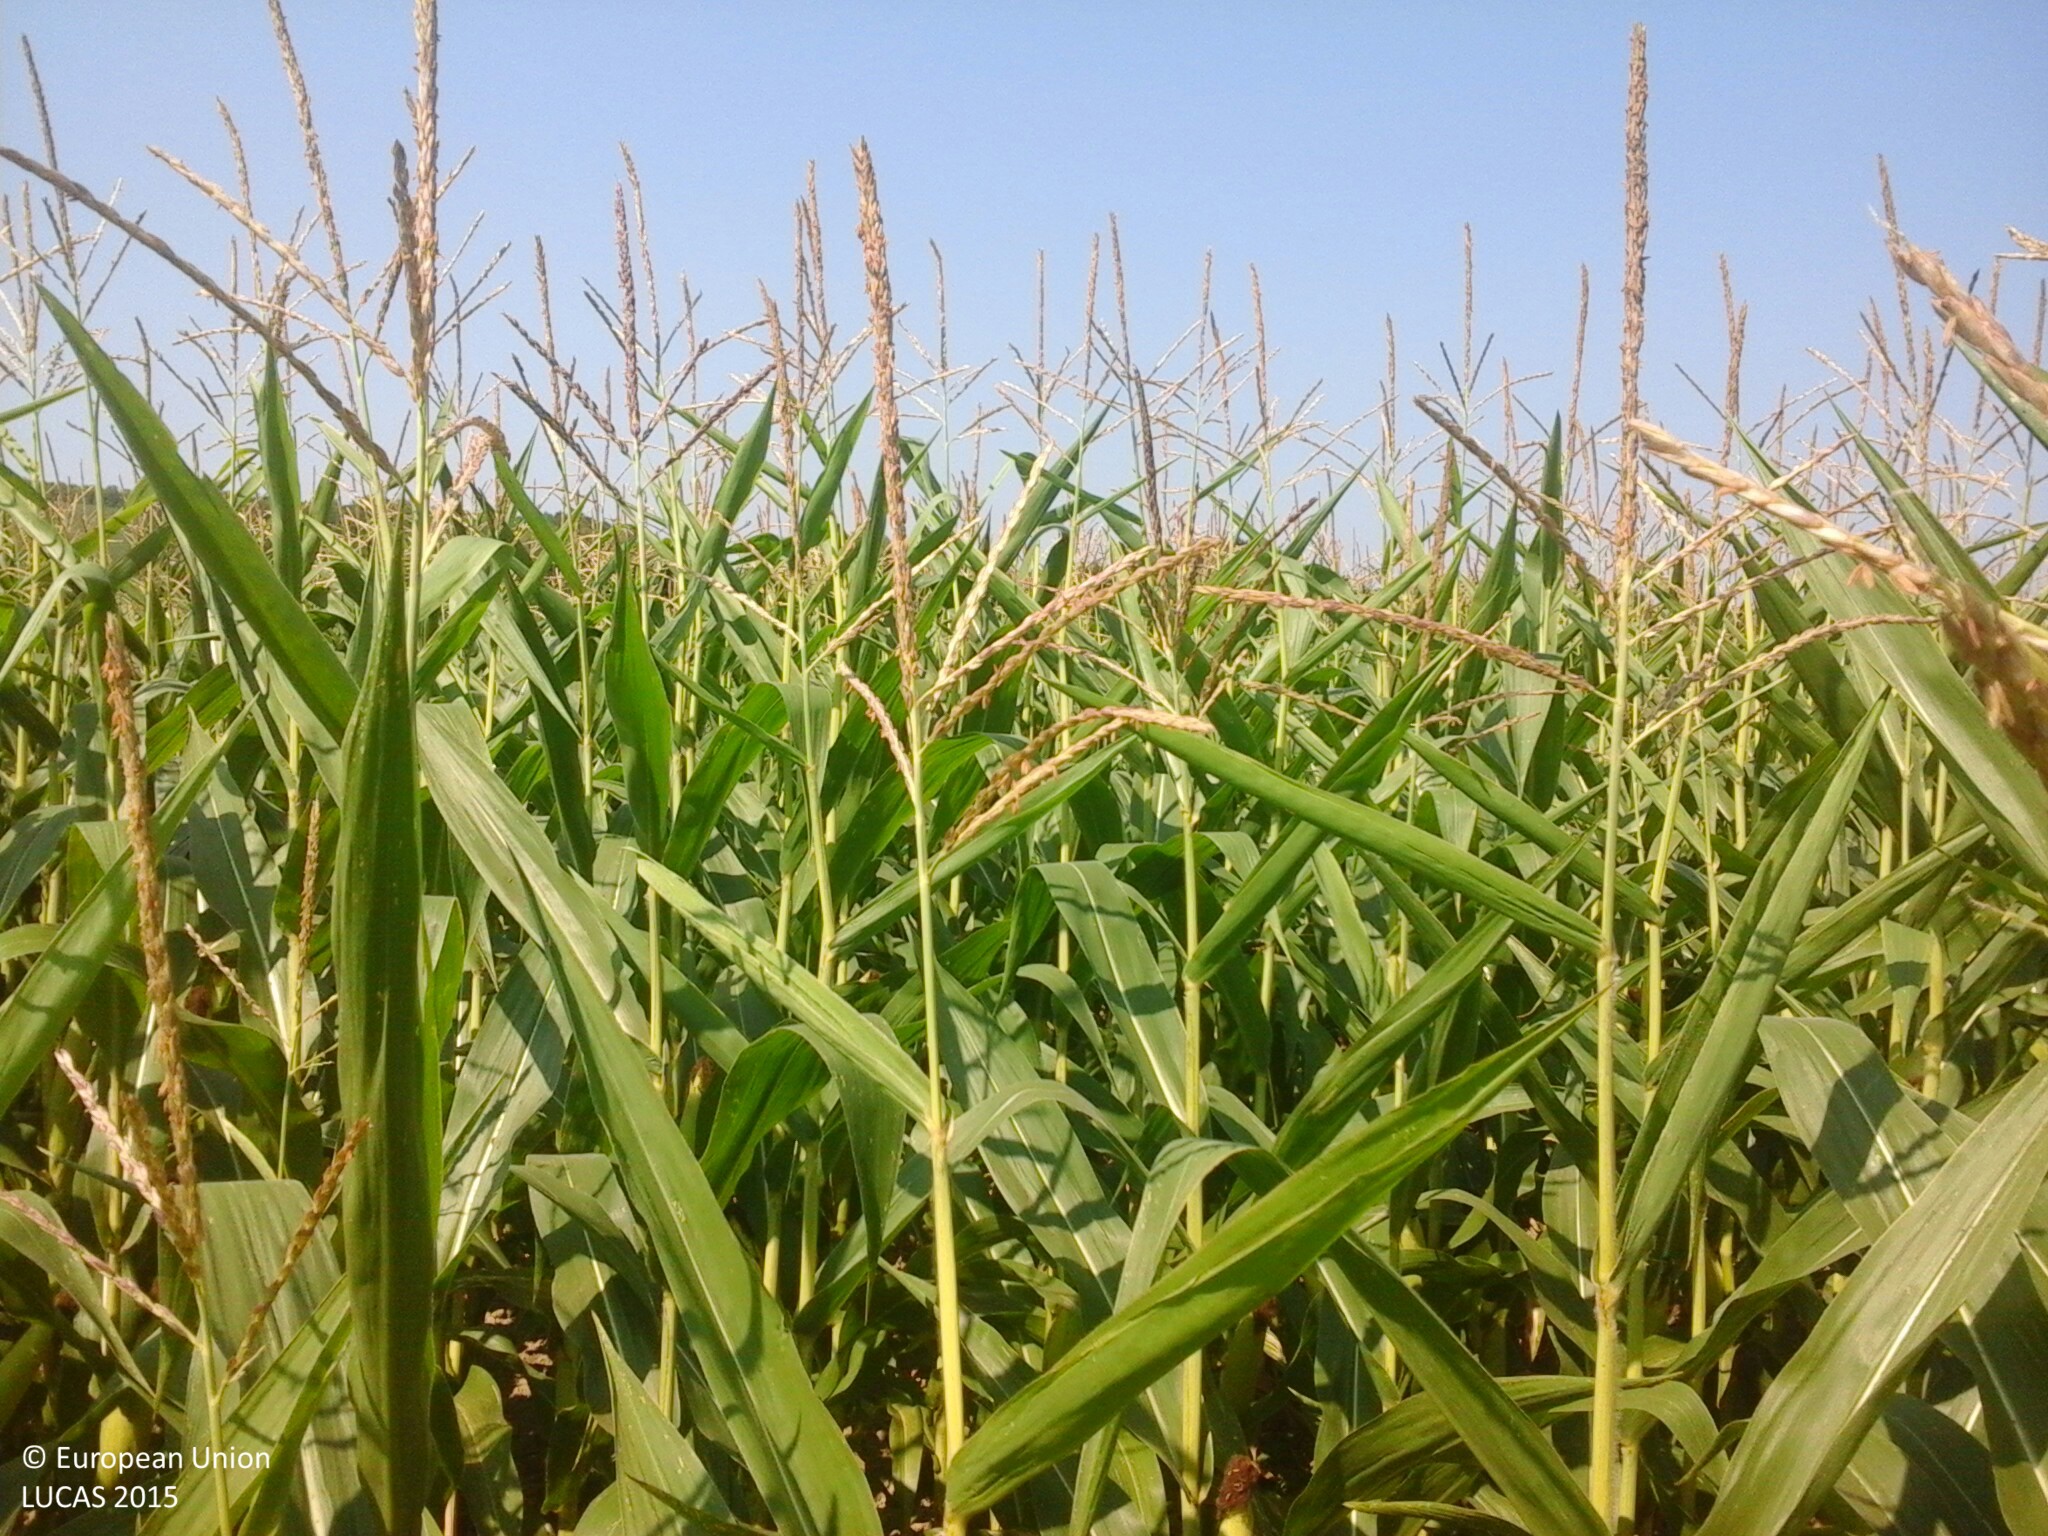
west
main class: Cropland
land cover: Maize
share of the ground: > 75 %
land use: Agriculture (excluding fallow land and kitchen gardens)
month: August
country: HU
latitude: 47.3644
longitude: 18.1013
